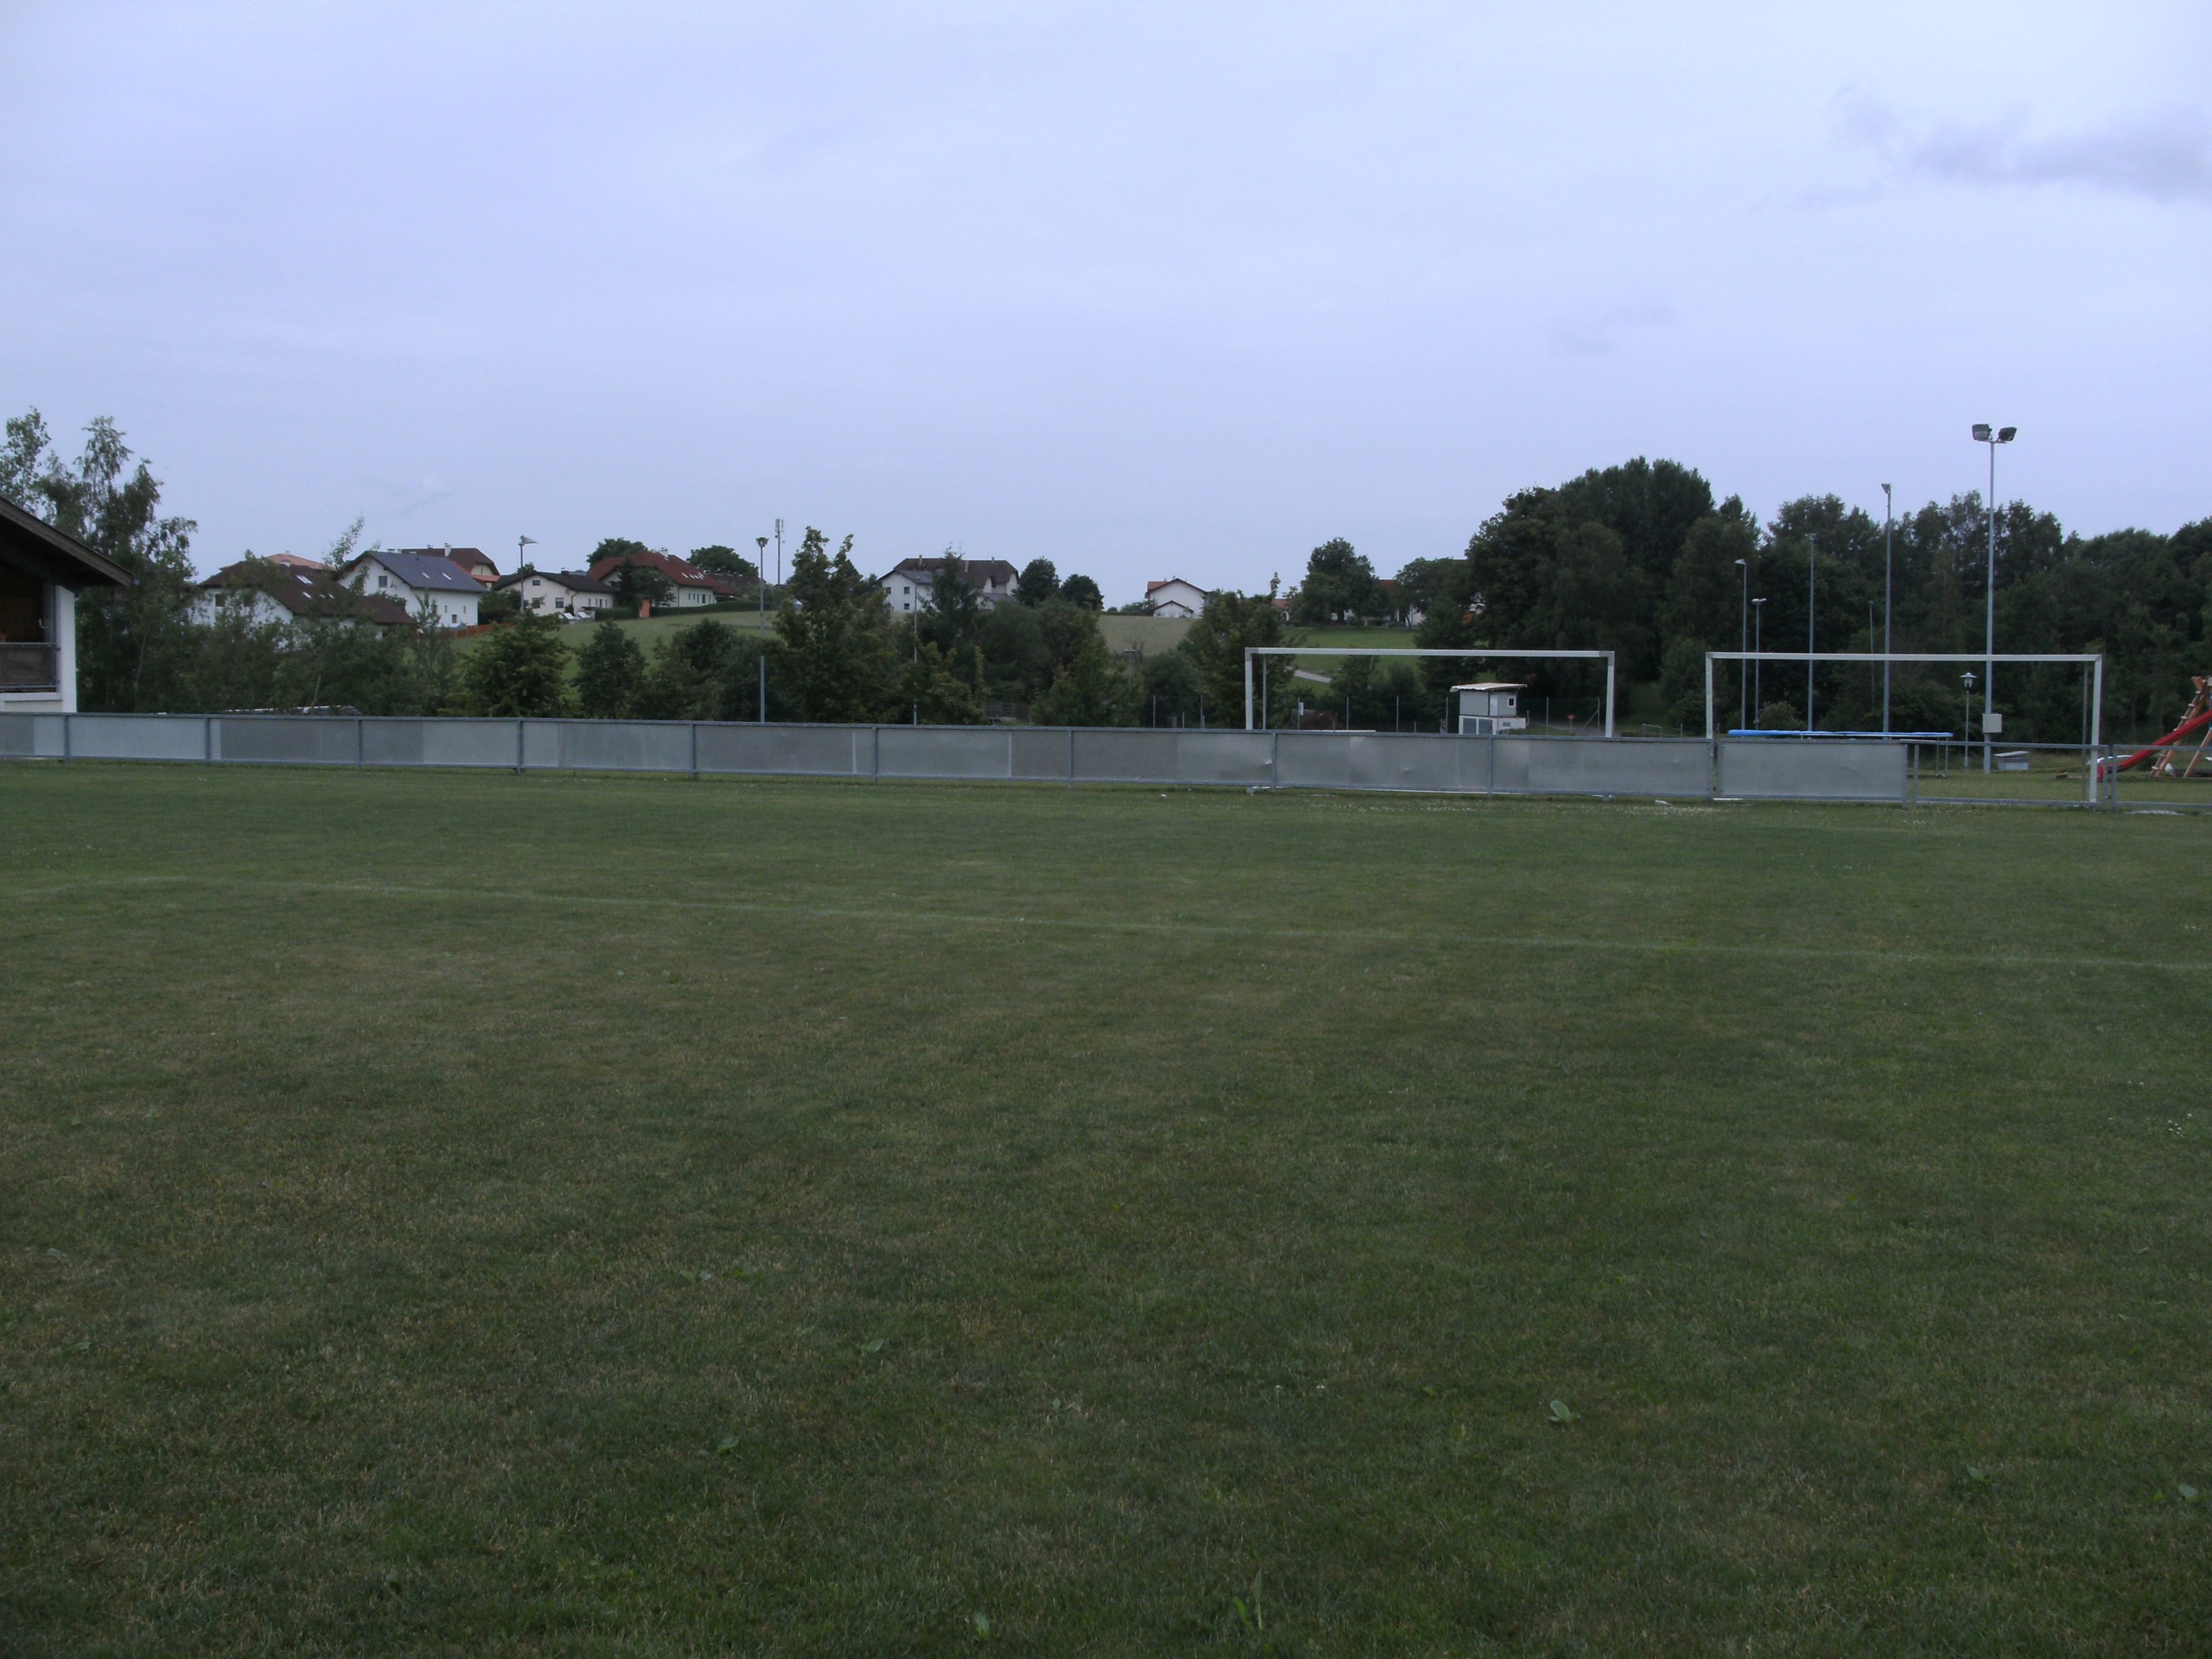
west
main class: Grassland
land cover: Grassland without tree/shrub cover
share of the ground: > 75 %
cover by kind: herbaceous plants 100 %
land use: Sport
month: June
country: AT
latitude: 48.4348
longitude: 14.1226
